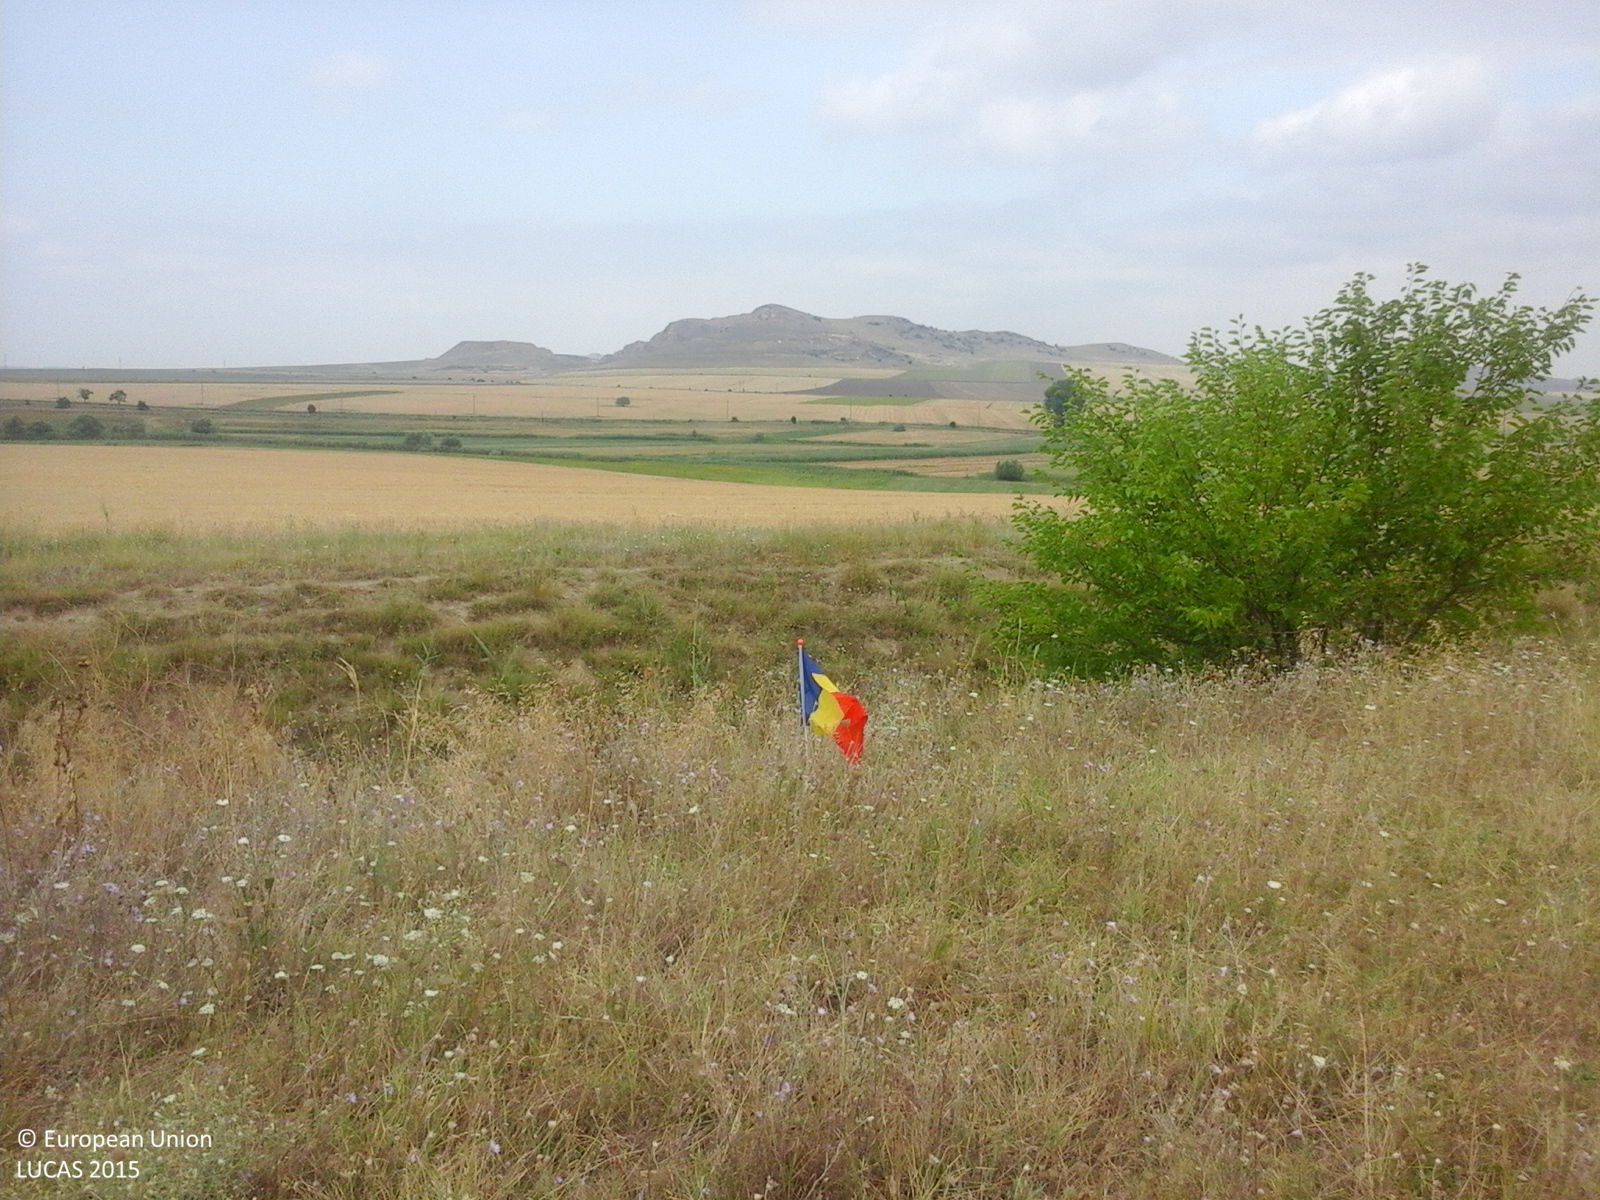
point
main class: Grassland
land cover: Grassland without tree/shrub cover
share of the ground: > 75 %
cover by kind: herbaceous plants 100 %
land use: Agriculture (excluding fallow land and kitchen gardens)
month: July
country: RO
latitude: 45.0558
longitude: 28.2676
